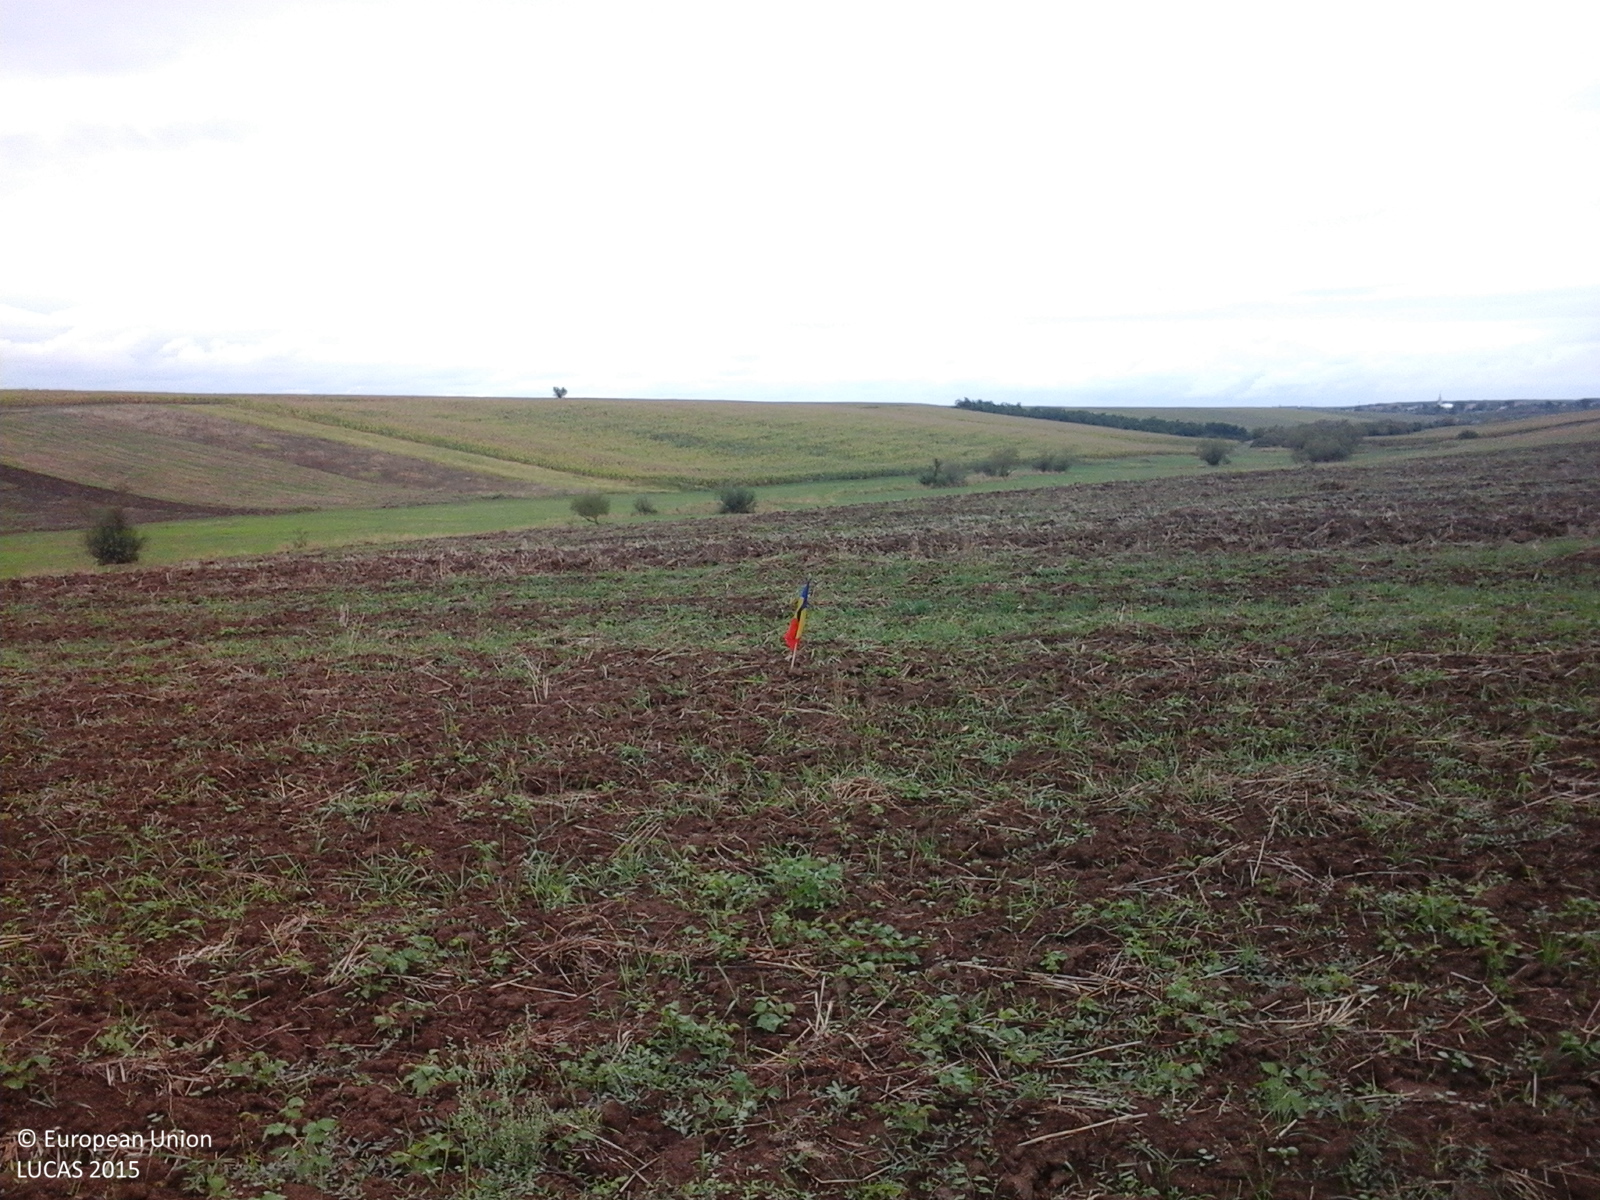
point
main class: Cropland
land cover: Common wheat
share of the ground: < 10 %
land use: Agriculture (excluding fallow land and kitchen gardens)
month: September
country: RO
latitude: 46.8708
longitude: 21.8652
